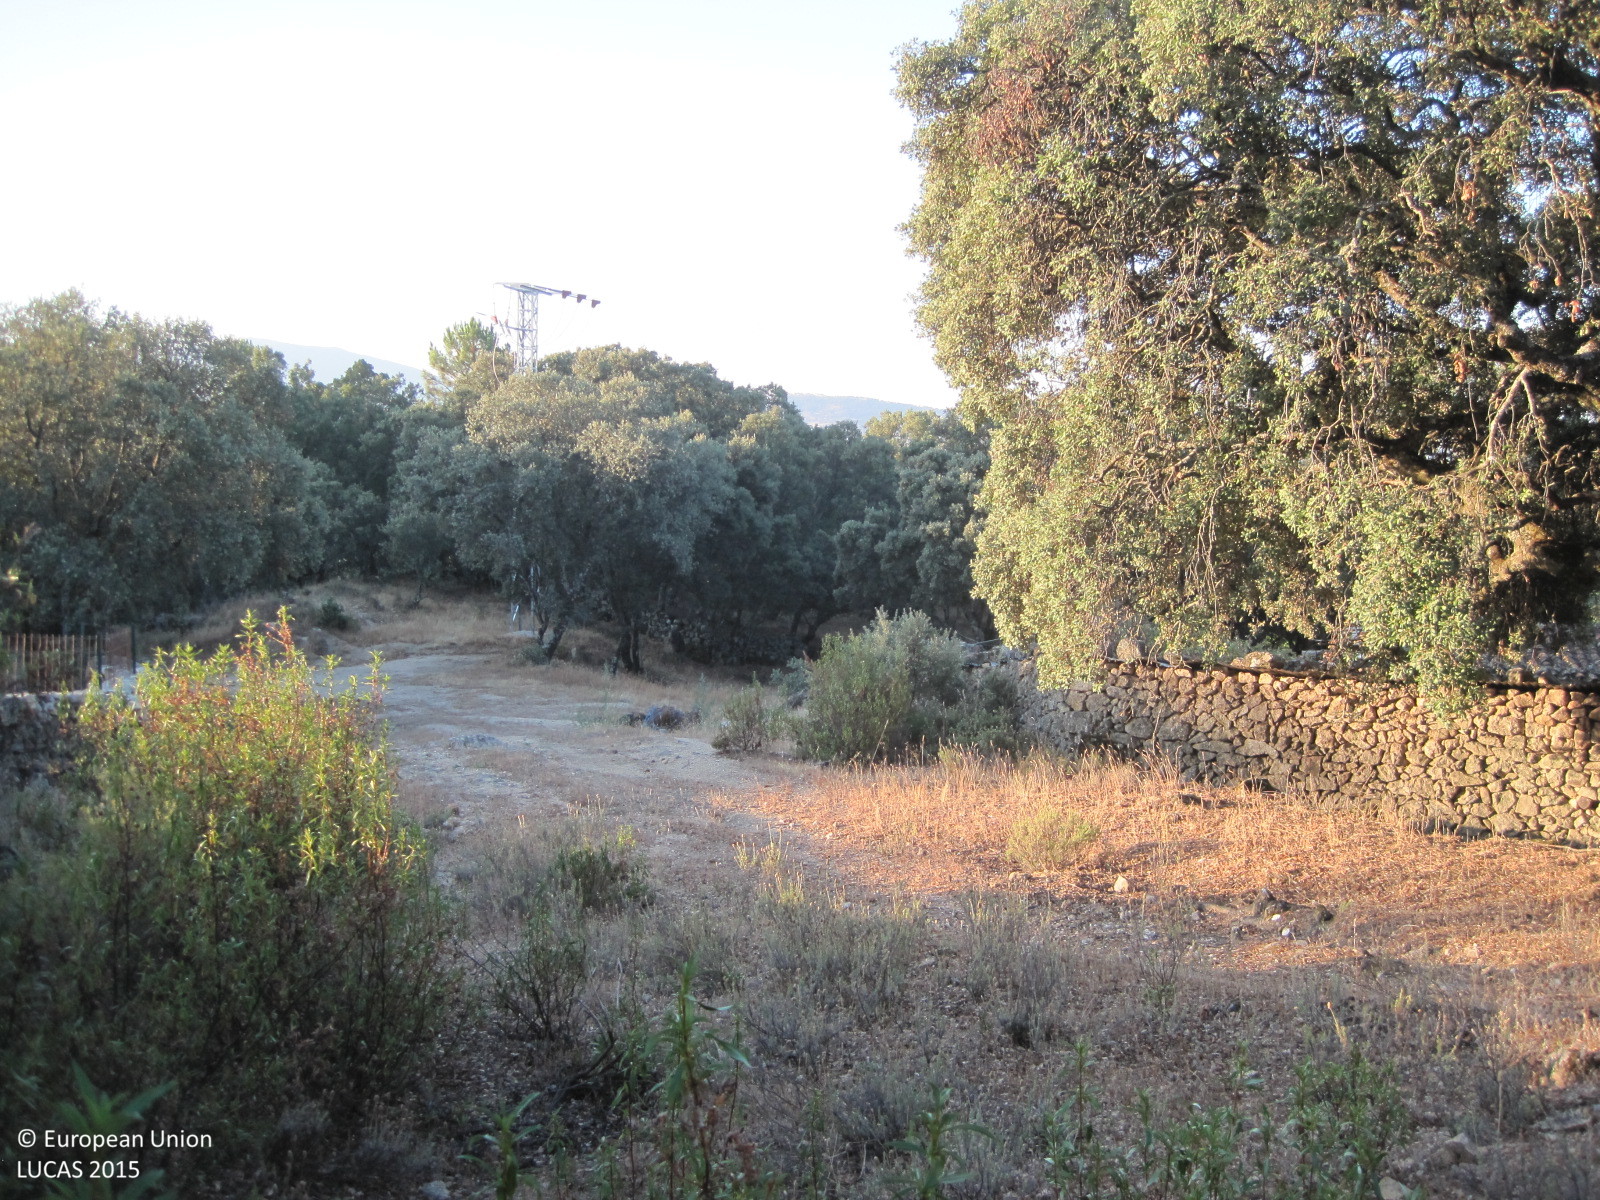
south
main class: Shrubland
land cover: Shrubland with sparse tree cover
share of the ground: > 75 %
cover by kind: shrubs 95 %, broadleaved forest trees 5 %
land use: Semi-natural and natural areas not in use
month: July
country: ES
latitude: 40.2495
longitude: -4.8534
